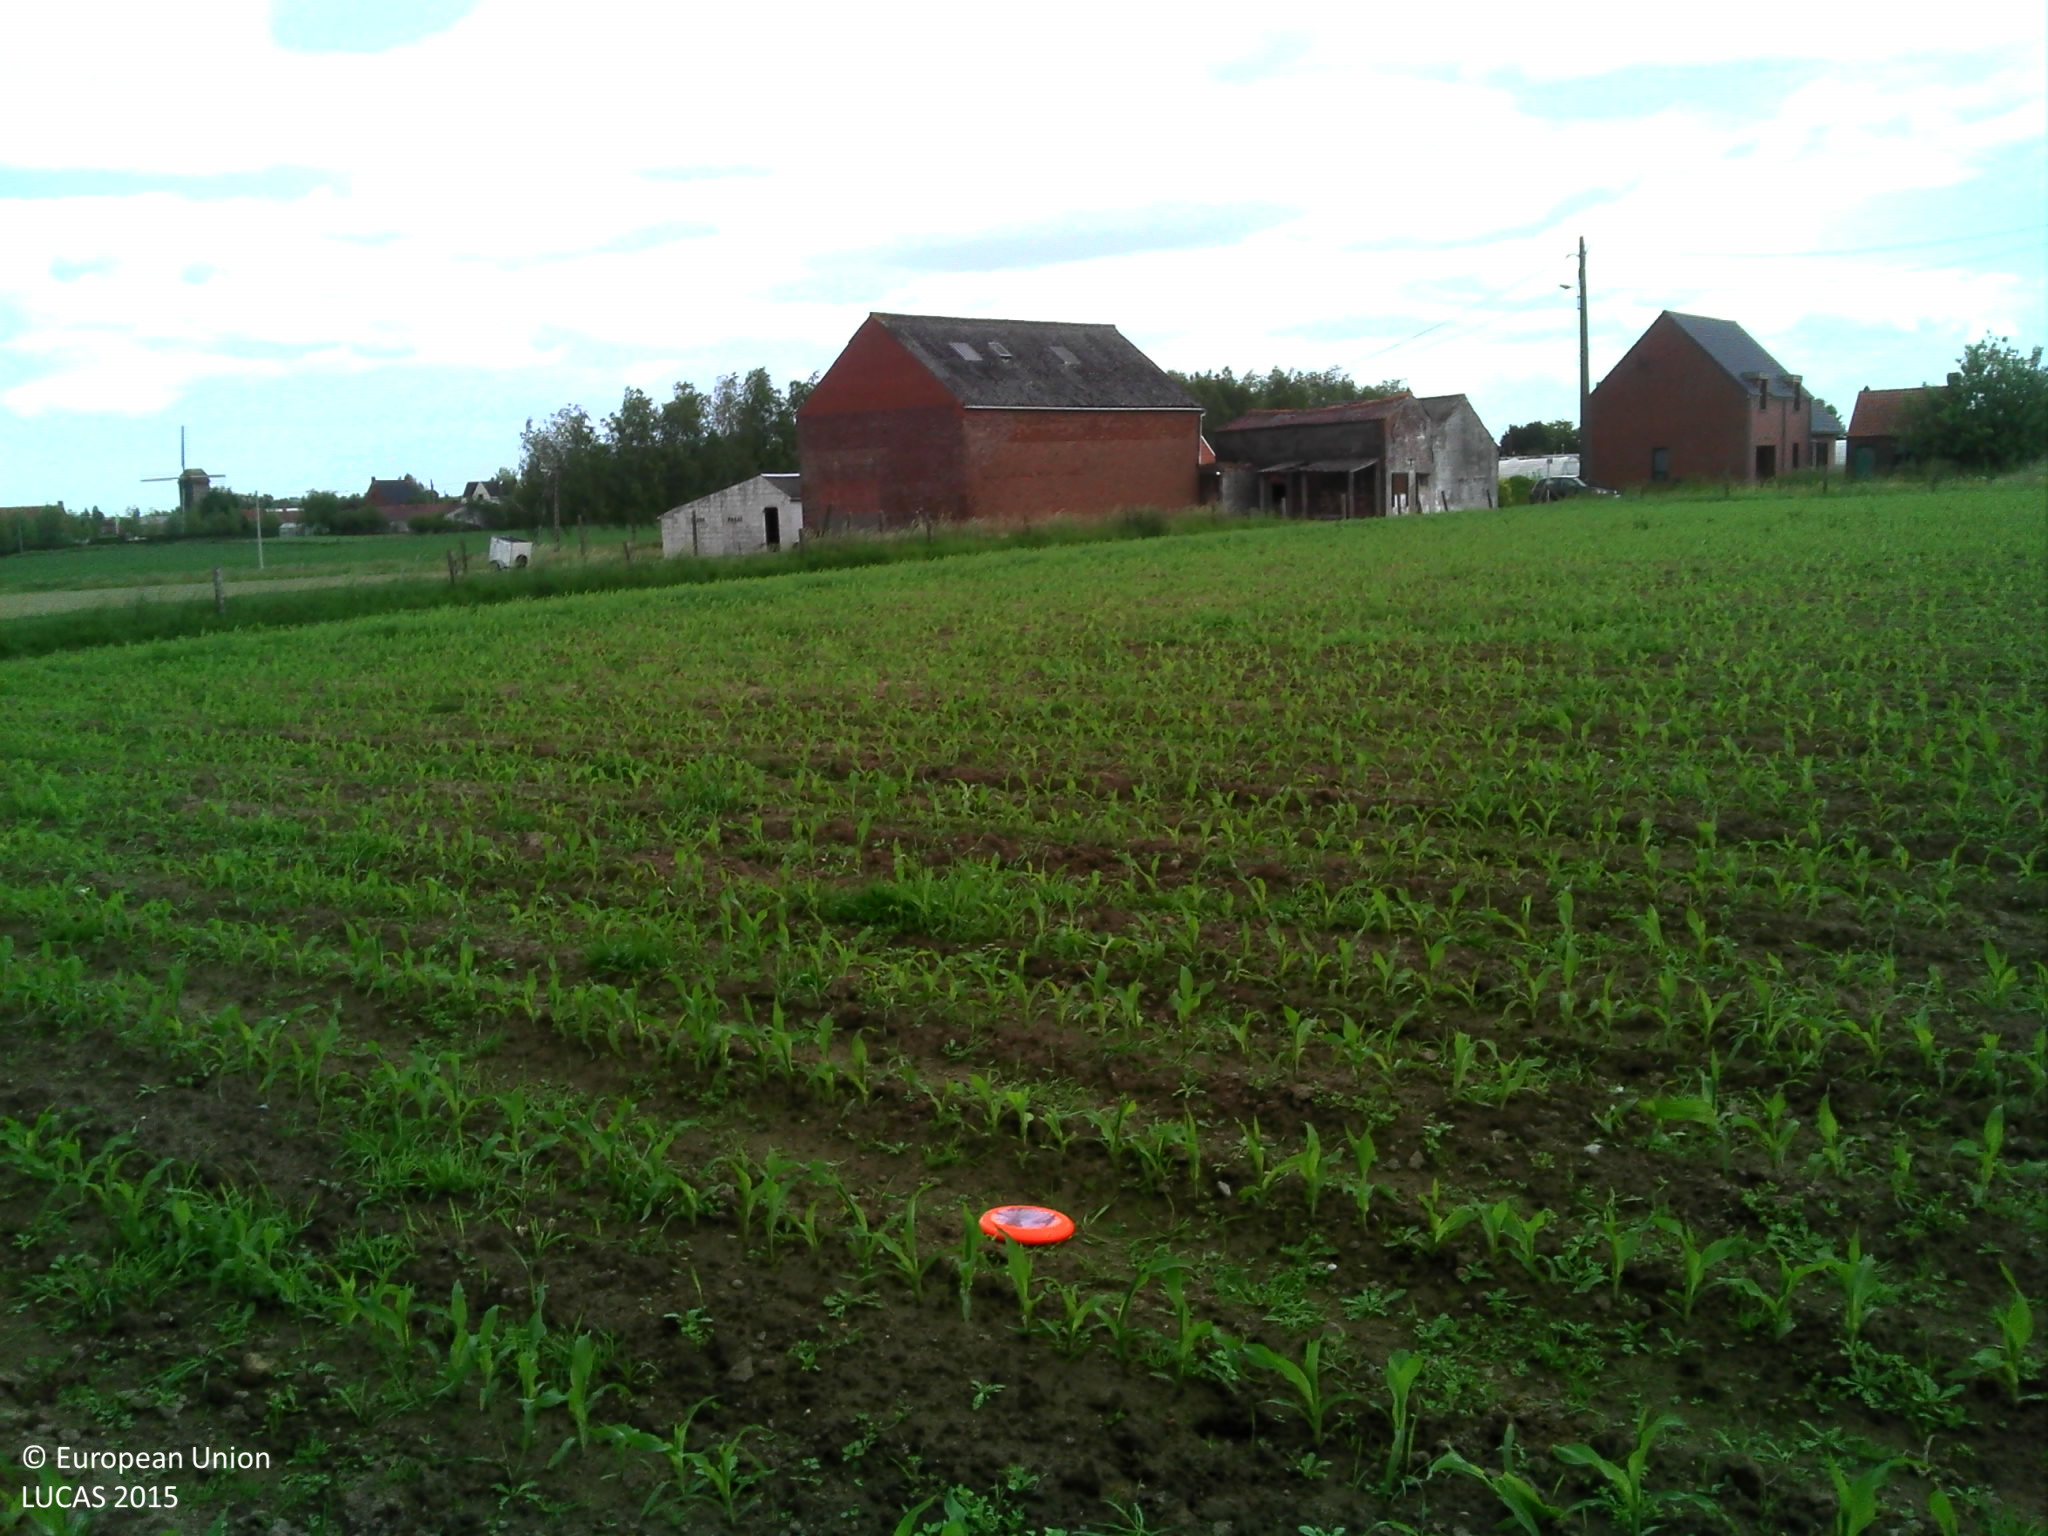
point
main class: Cropland
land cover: Maize
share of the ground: < 10 %
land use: Agriculture (excluding fallow land and kitchen gardens)
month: June
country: BE
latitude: 50.8256
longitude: 3.4474
